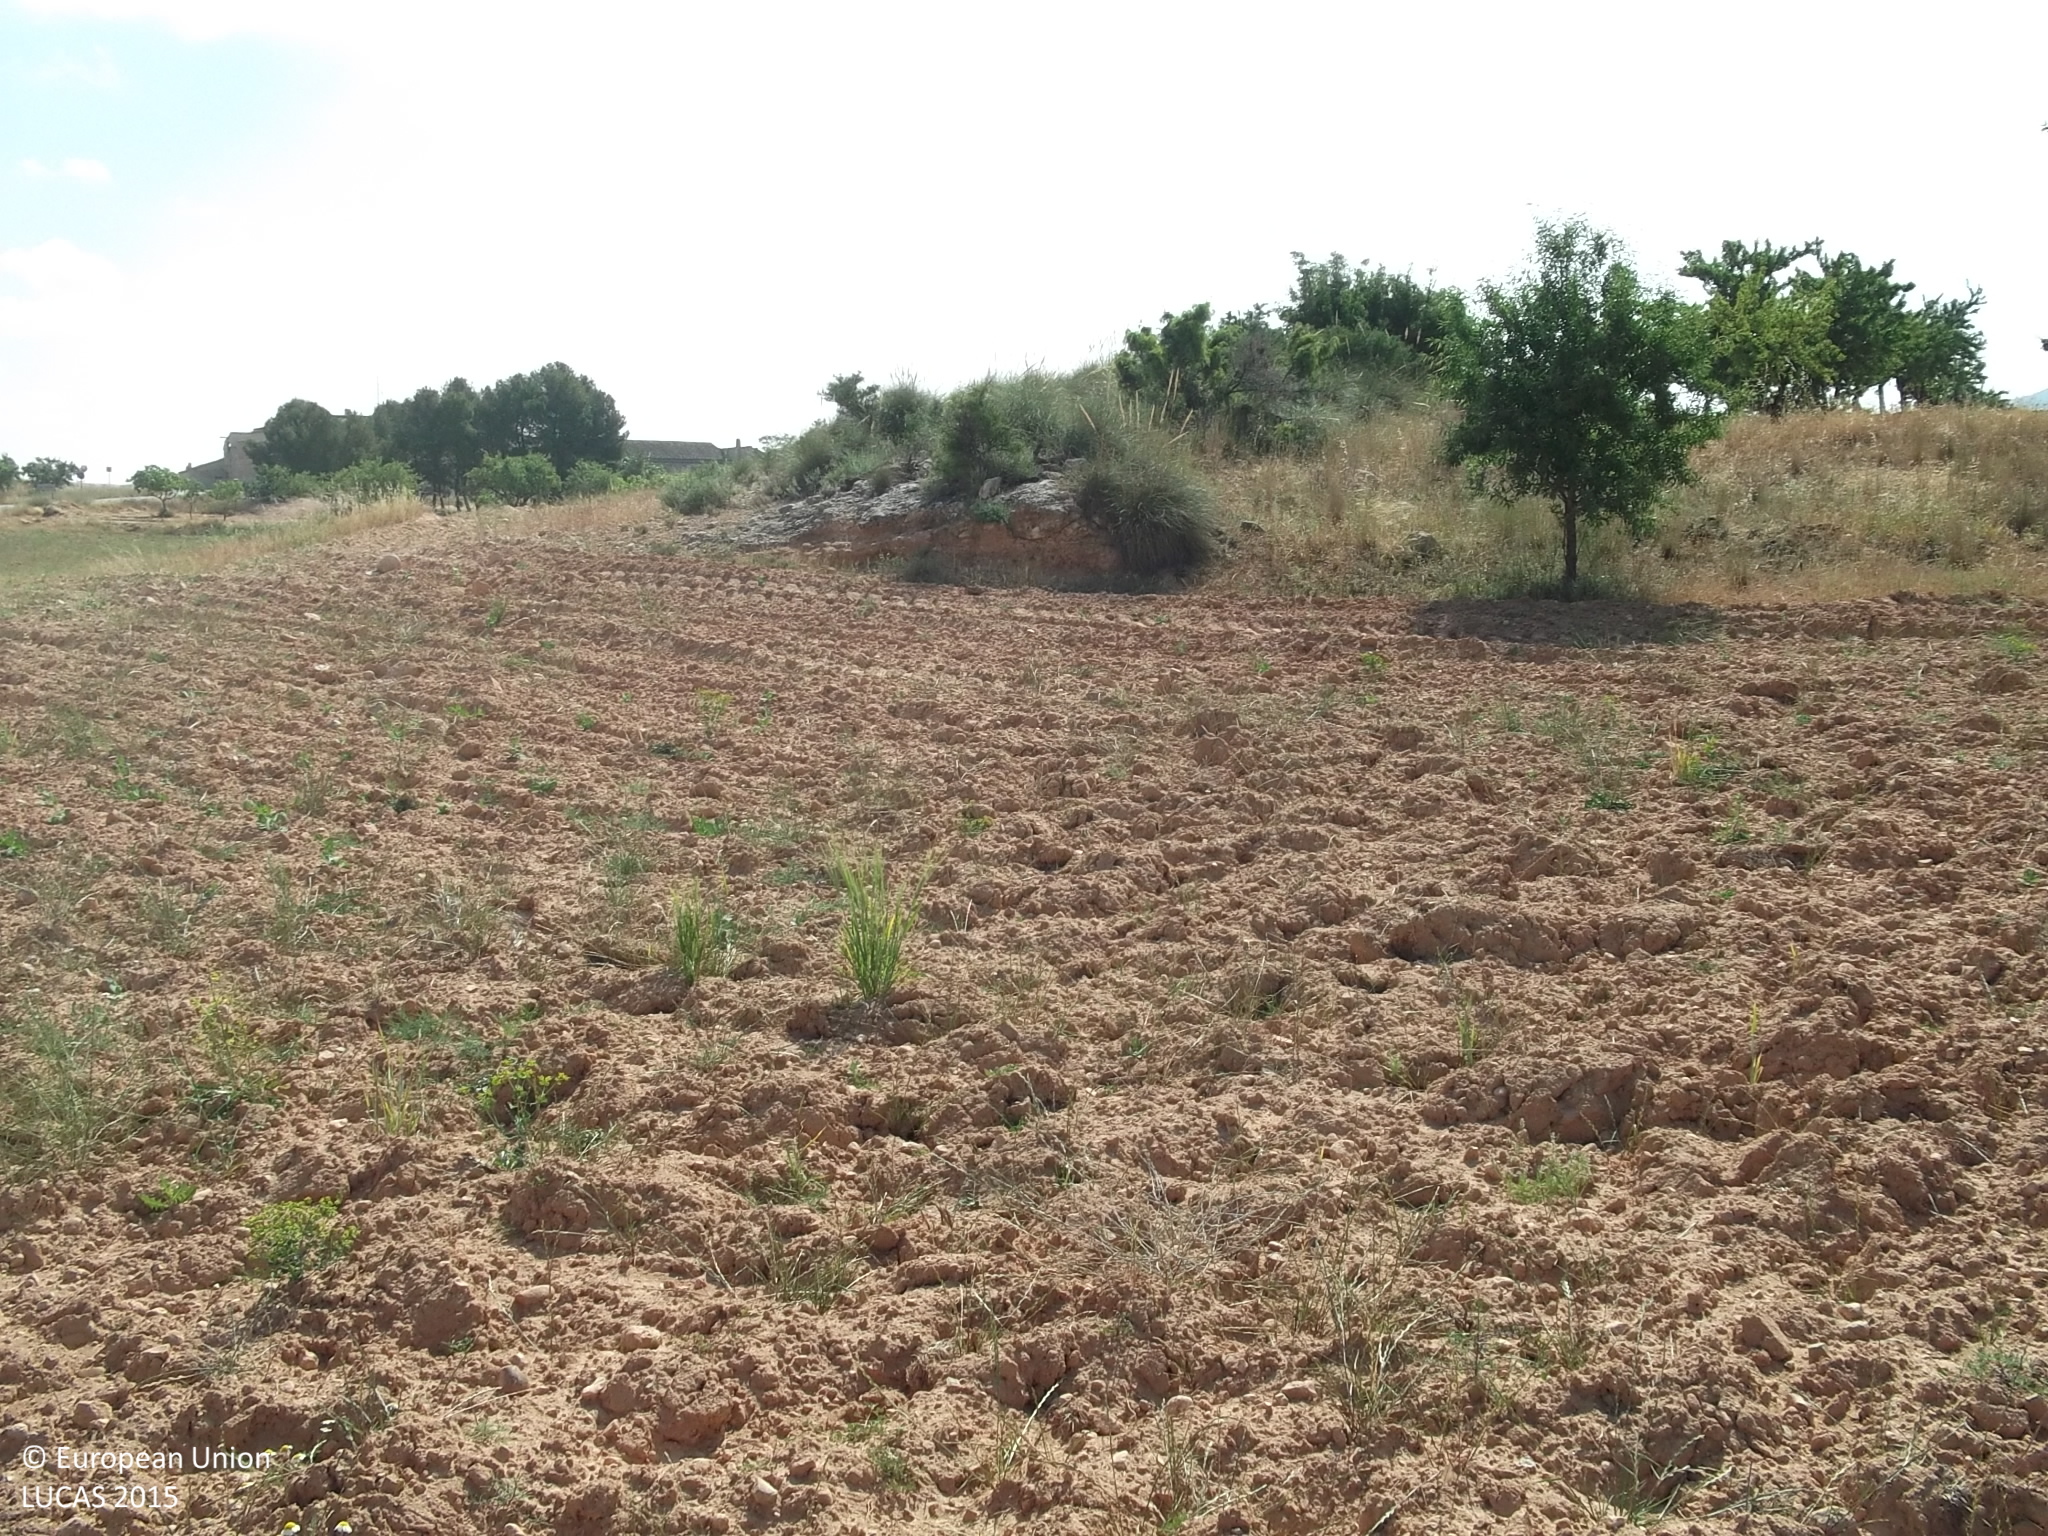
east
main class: Grassland
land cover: Spontaneously vegetated surfaces
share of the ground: 25 - 50 %
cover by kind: unconsolidated bare surface 75 %, herbaceous plants 25 %
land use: Fallow land
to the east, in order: Spontaneously vegetated surfaces; Shrubland without tree cover; Nuts trees; Shrubland without tree cover; Tracks; Shrubland without tree cover; Artificial constructions in urban areas; Spontaneously vegetated surfaces
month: May
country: ES
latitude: 38.4604
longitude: -1.4629
